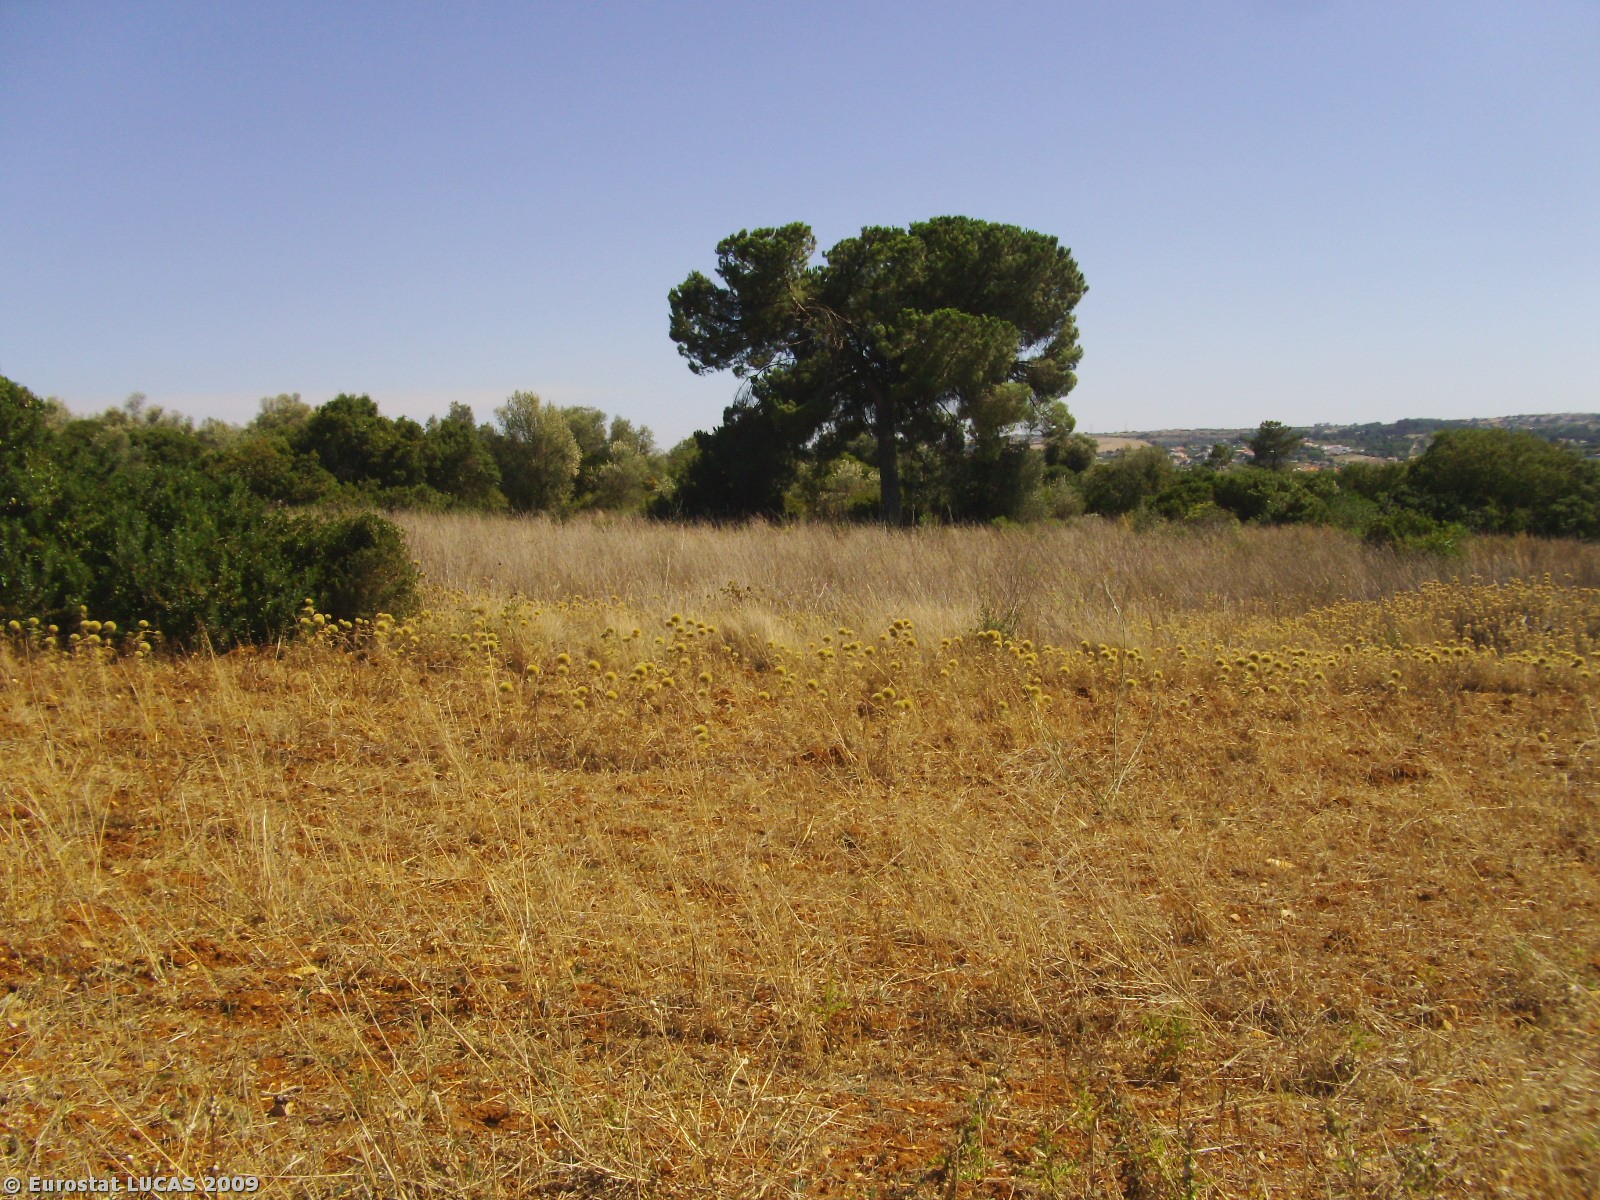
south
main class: Grassland
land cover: Spontaneously vegetated surfaces
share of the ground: > 75 %
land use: Fallow land
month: July
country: PT
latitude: 39.1649
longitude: -8.8362
